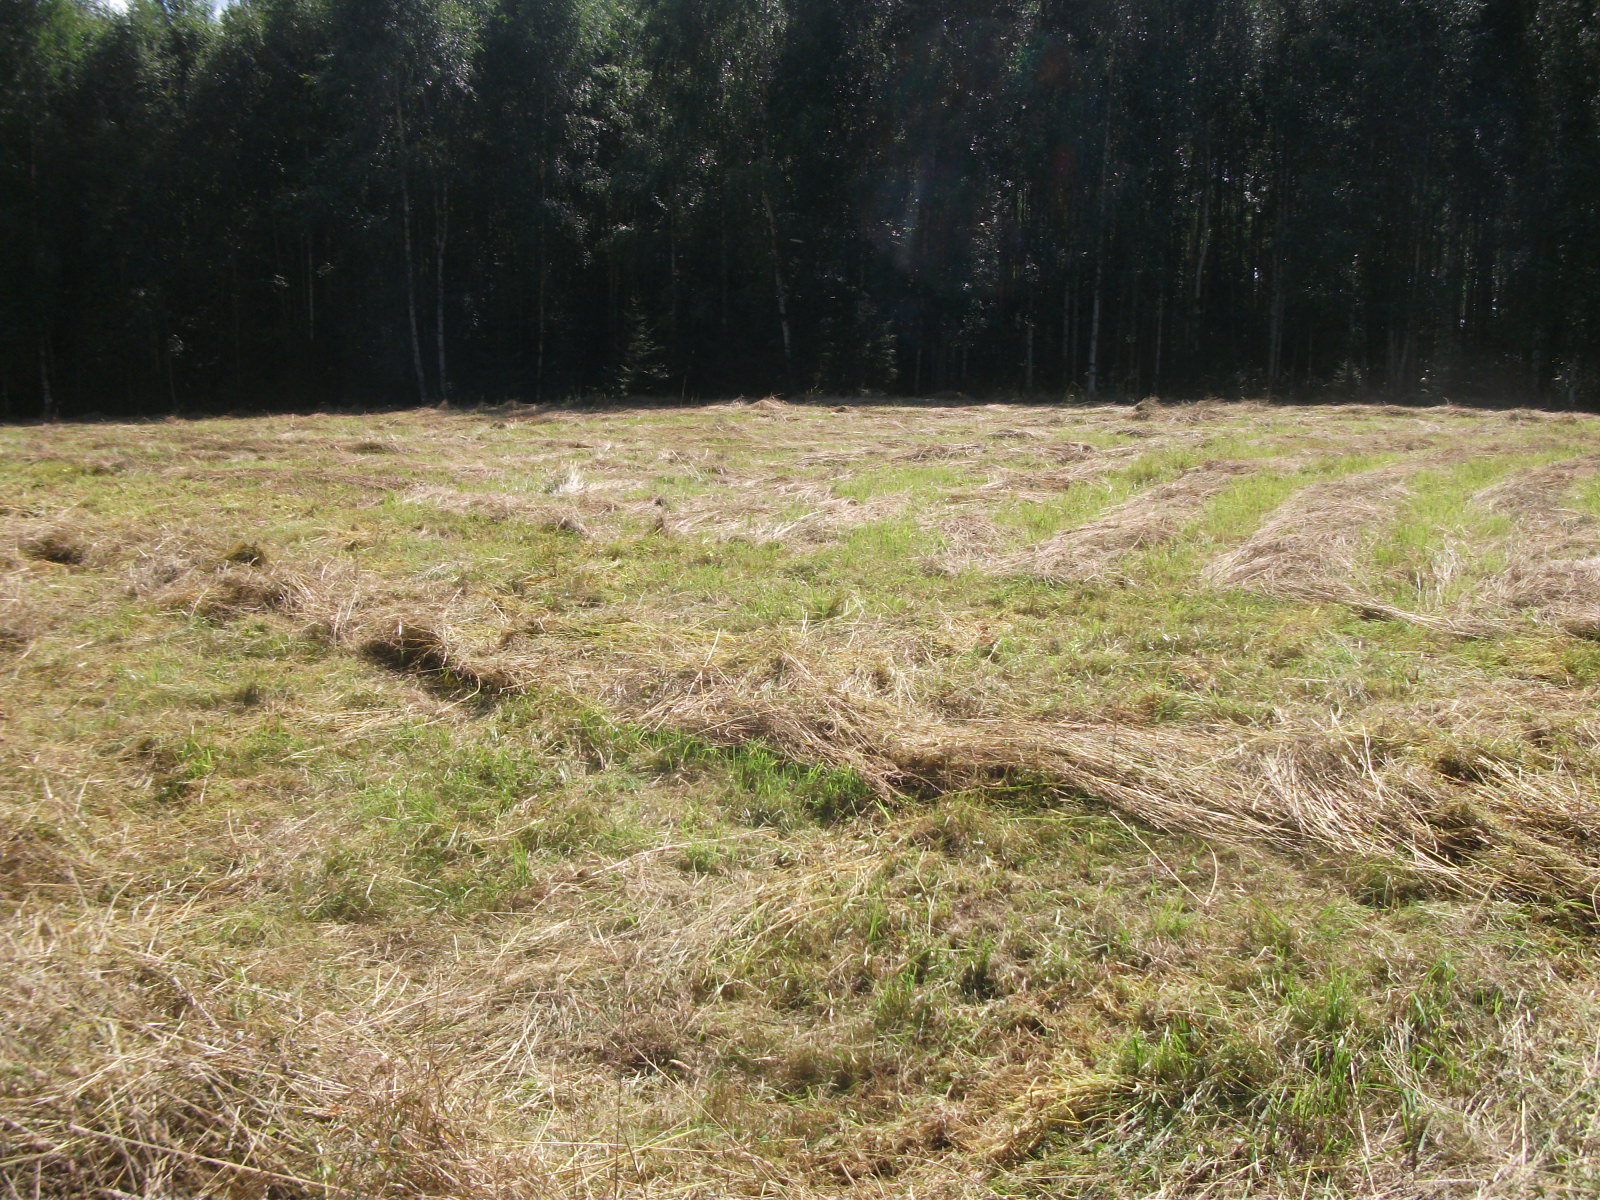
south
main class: Grassland
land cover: Grassland without tree/shrub cover
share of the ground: > 75 %
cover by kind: herbaceous plants 100 %
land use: Agriculture (excluding fallow land and kitchen gardens)
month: August
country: LV
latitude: 57.0930
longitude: 26.6703
